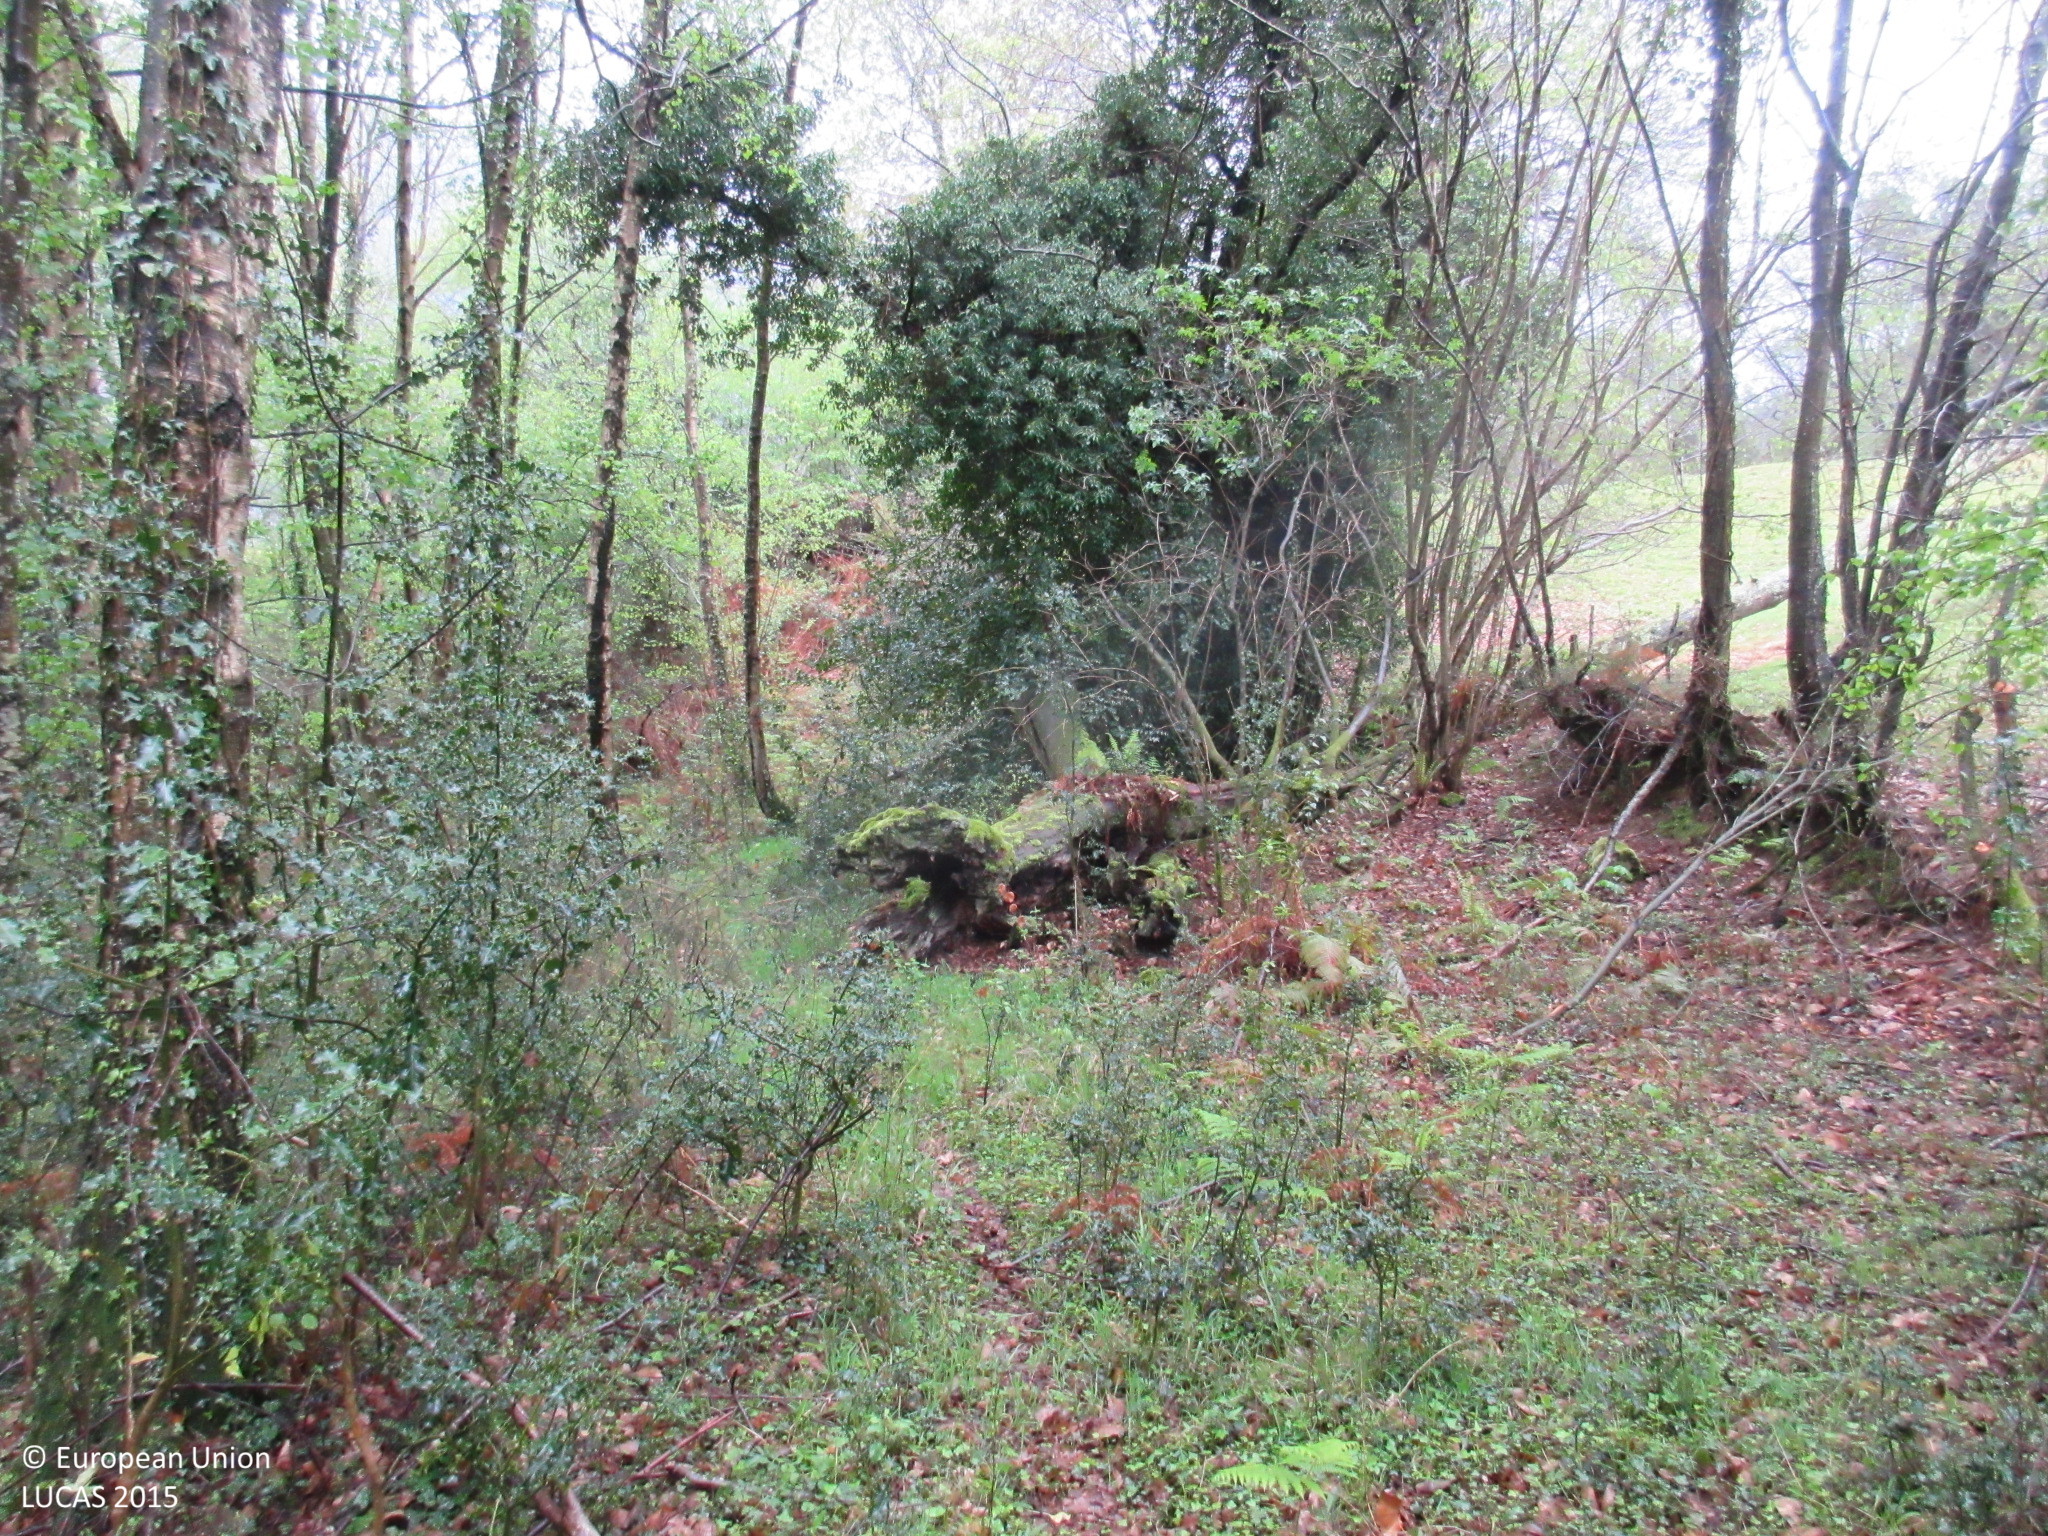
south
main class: Woodland
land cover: Broadleaved woodland
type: acidophilous oak and oak-birch forest
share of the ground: > 75 %
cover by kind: broadleaved forest trees 100 %
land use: Forestry
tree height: > 5 m
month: April
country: ES
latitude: 43.4481
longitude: -5.2879
